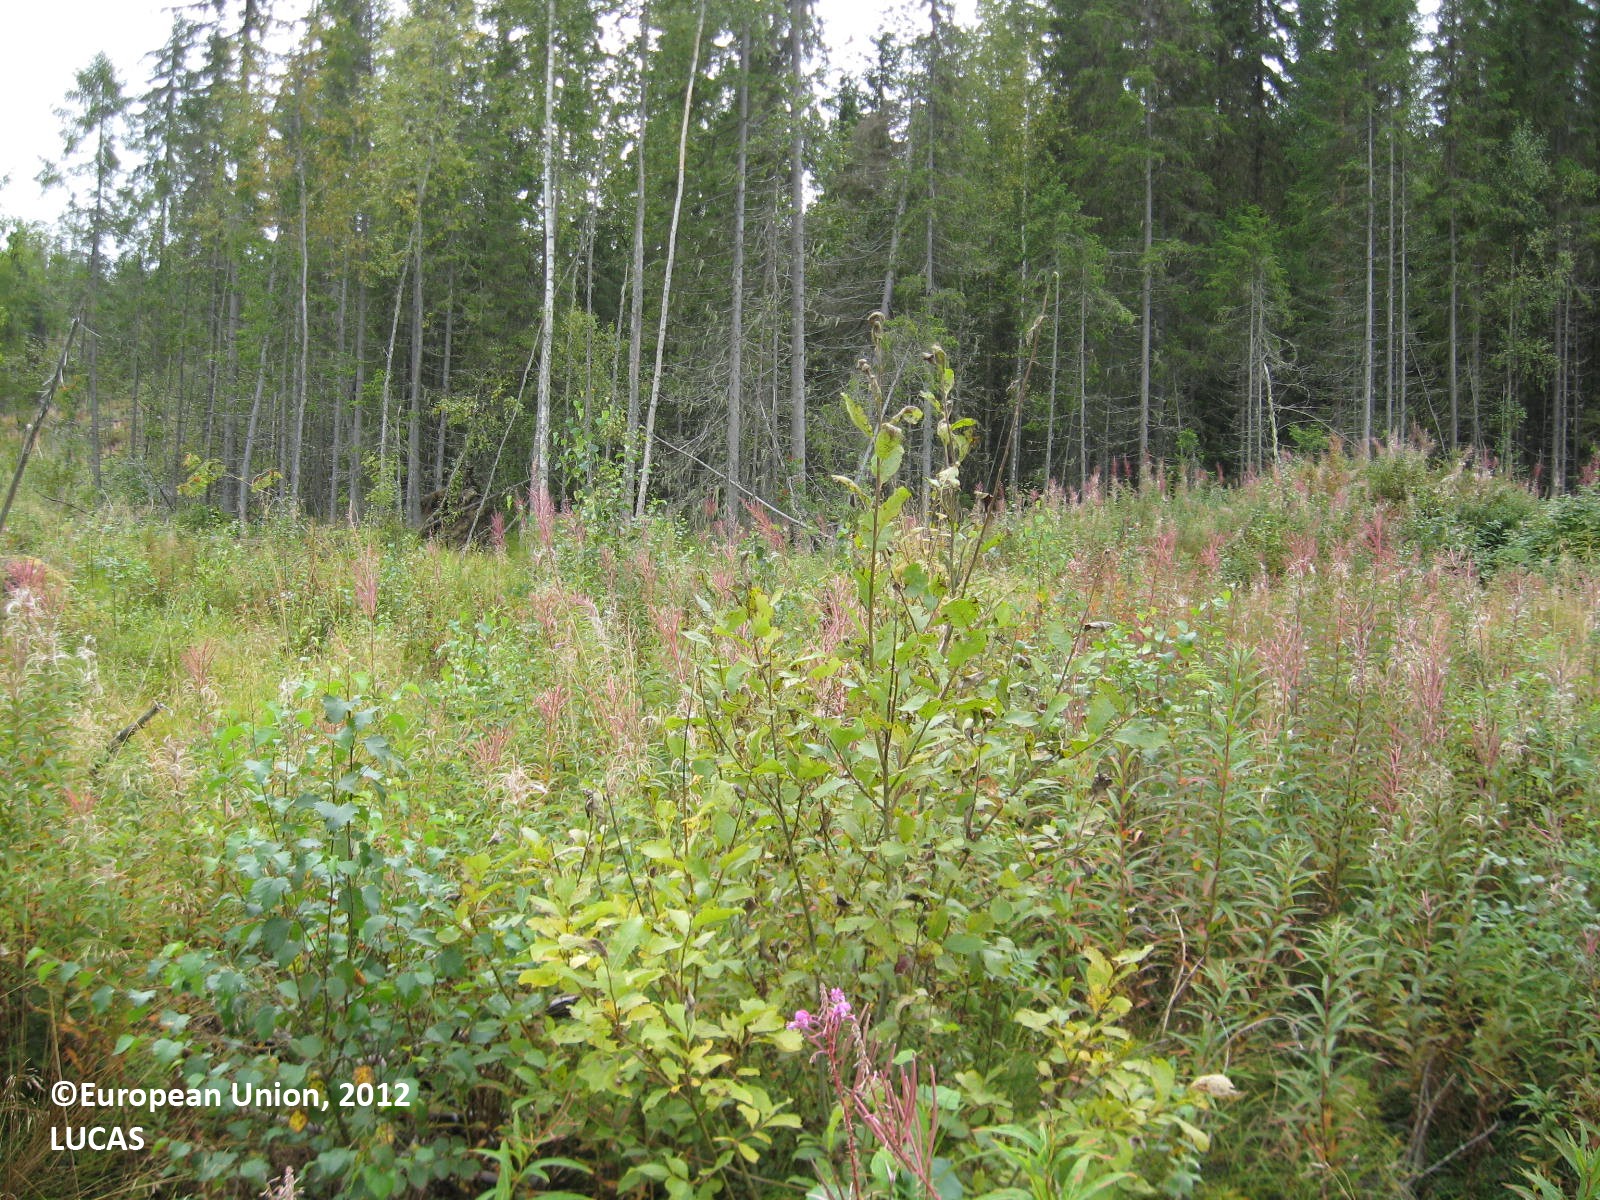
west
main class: Shrubland
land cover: Shrubland without tree cover
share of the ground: 50 - 75 %
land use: Forestry
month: August
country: FI
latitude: 63.6603
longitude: 29.0132
